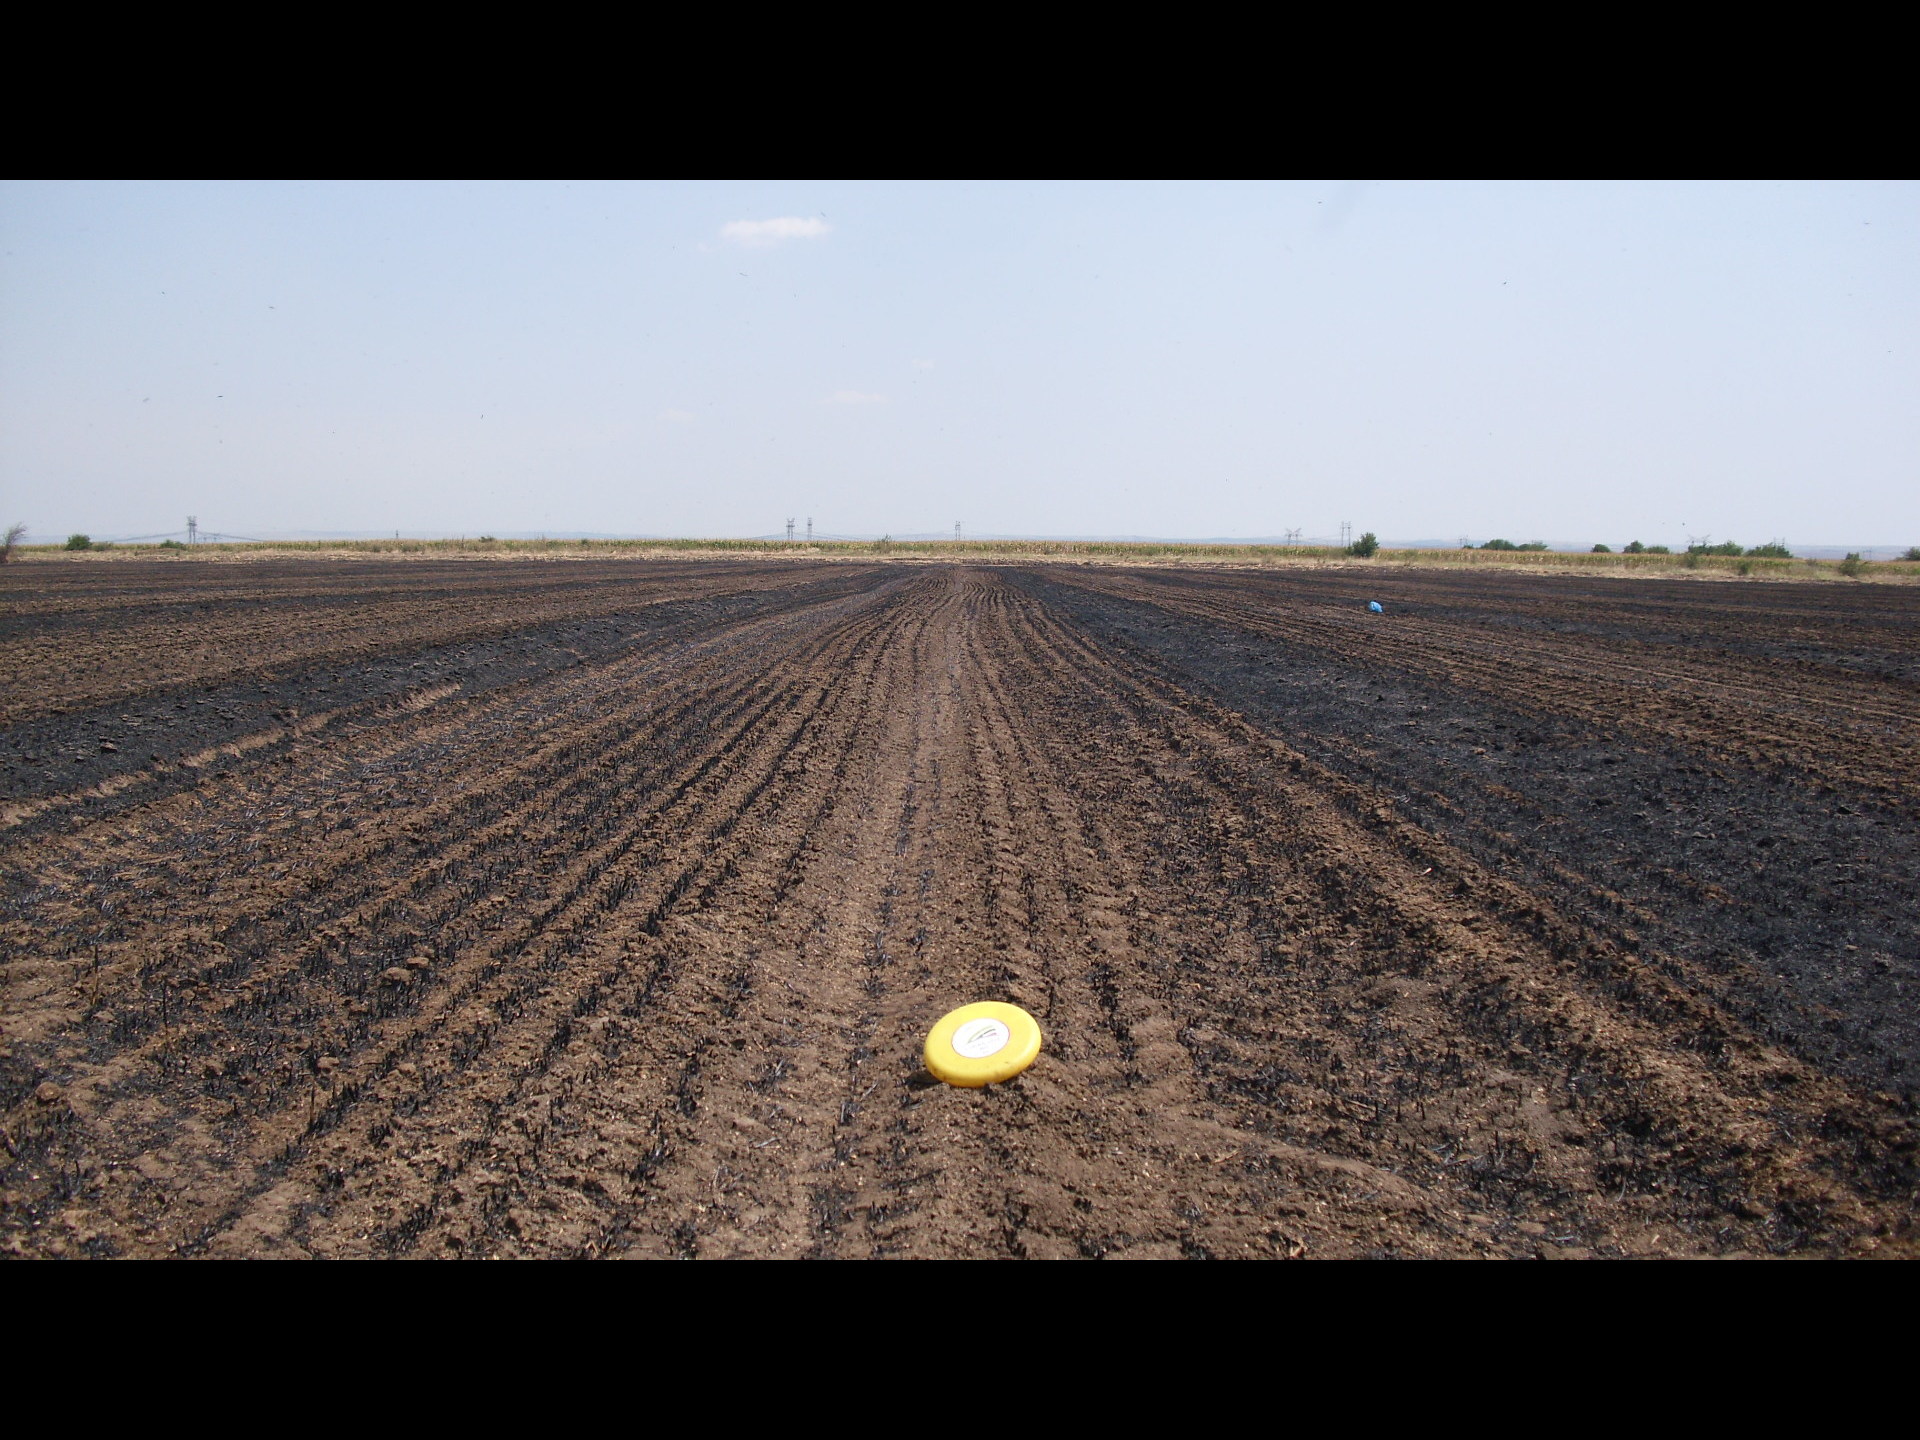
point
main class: Cropland
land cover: Common wheat
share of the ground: < 10 %
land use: Agriculture (excluding fallow land and kitchen gardens)
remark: Burnt area
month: August
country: BG
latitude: 43.7092
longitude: 23.7138
